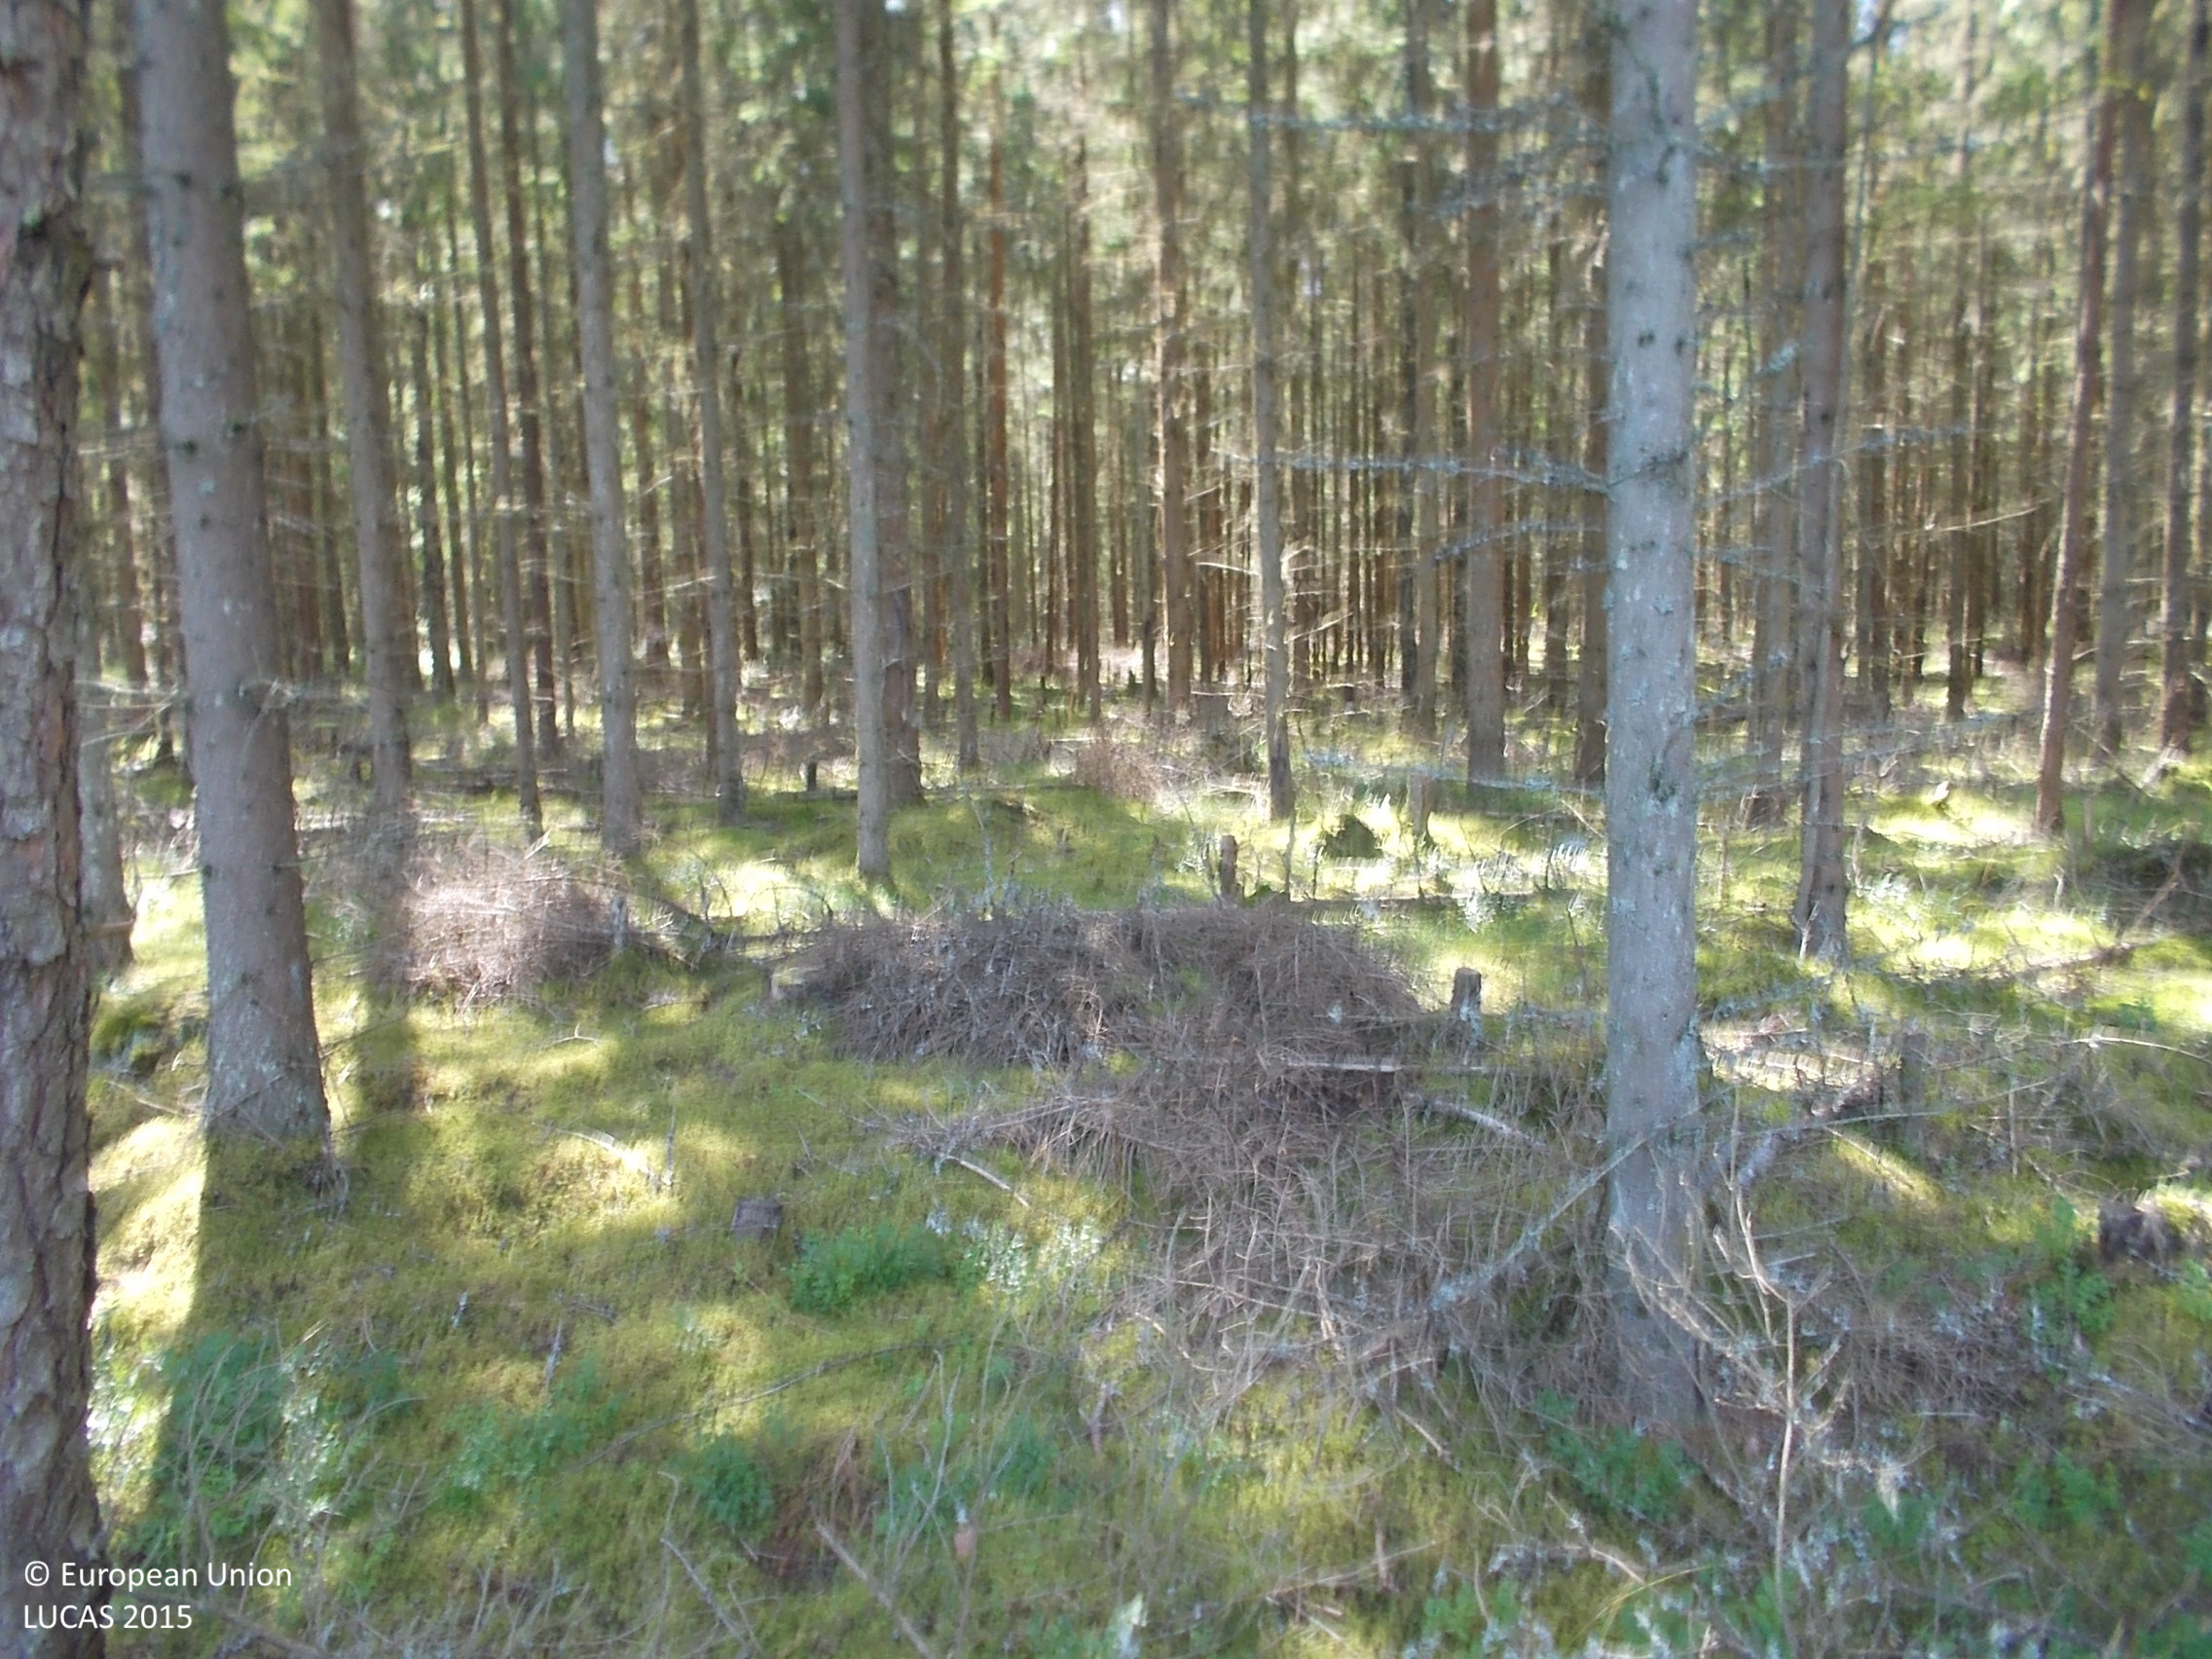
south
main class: Woodland
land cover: Spruce dominated coniferous woodland
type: boreal forest
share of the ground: > 75 %
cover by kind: coniferous forest trees 85 %, lichens and mosses 10 %, shrubs 5 %
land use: Forestry
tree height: > 5 m
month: August
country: SE
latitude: 57.6056
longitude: 13.1920
